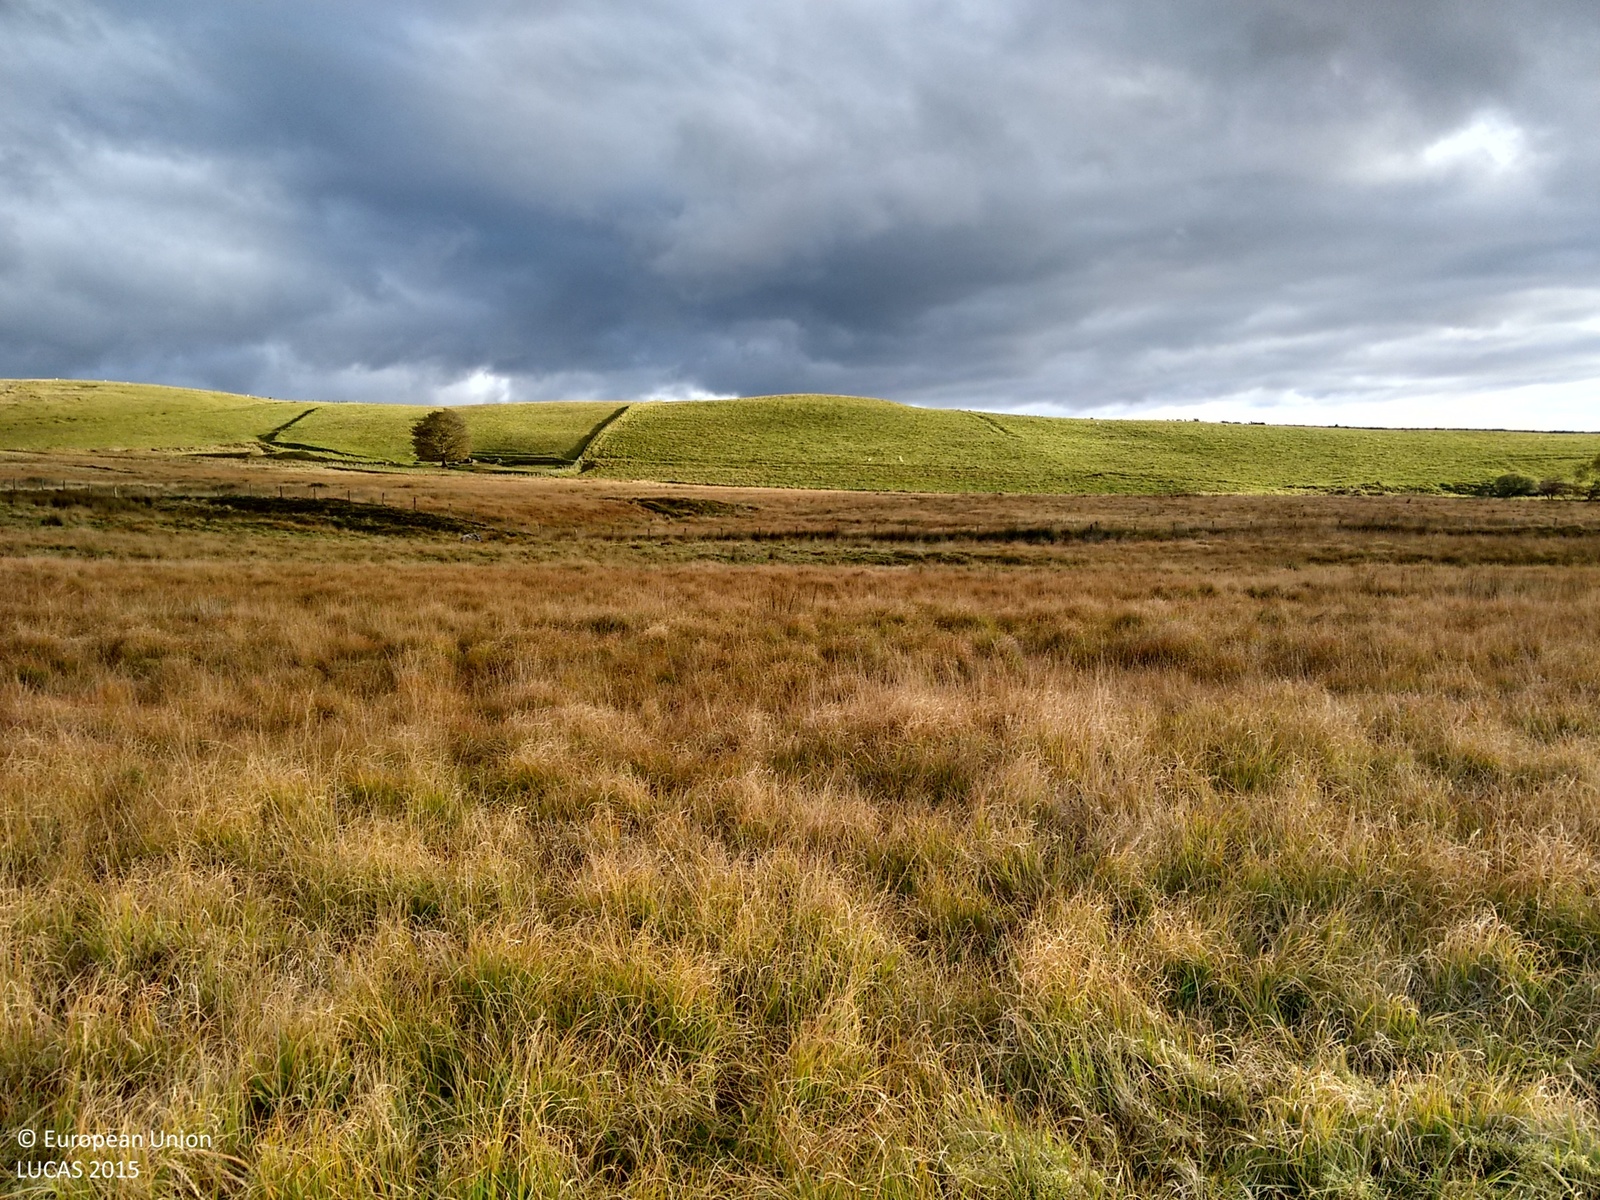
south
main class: Grassland
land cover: Grassland without tree/shrub cover
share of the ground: > 75 %
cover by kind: herbaceous plants 90 %, lichens and mosses 10 %
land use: Agriculture (excluding fallow land and kitchen gardens)
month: October
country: GB
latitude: 52.3105
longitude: -3.8348
